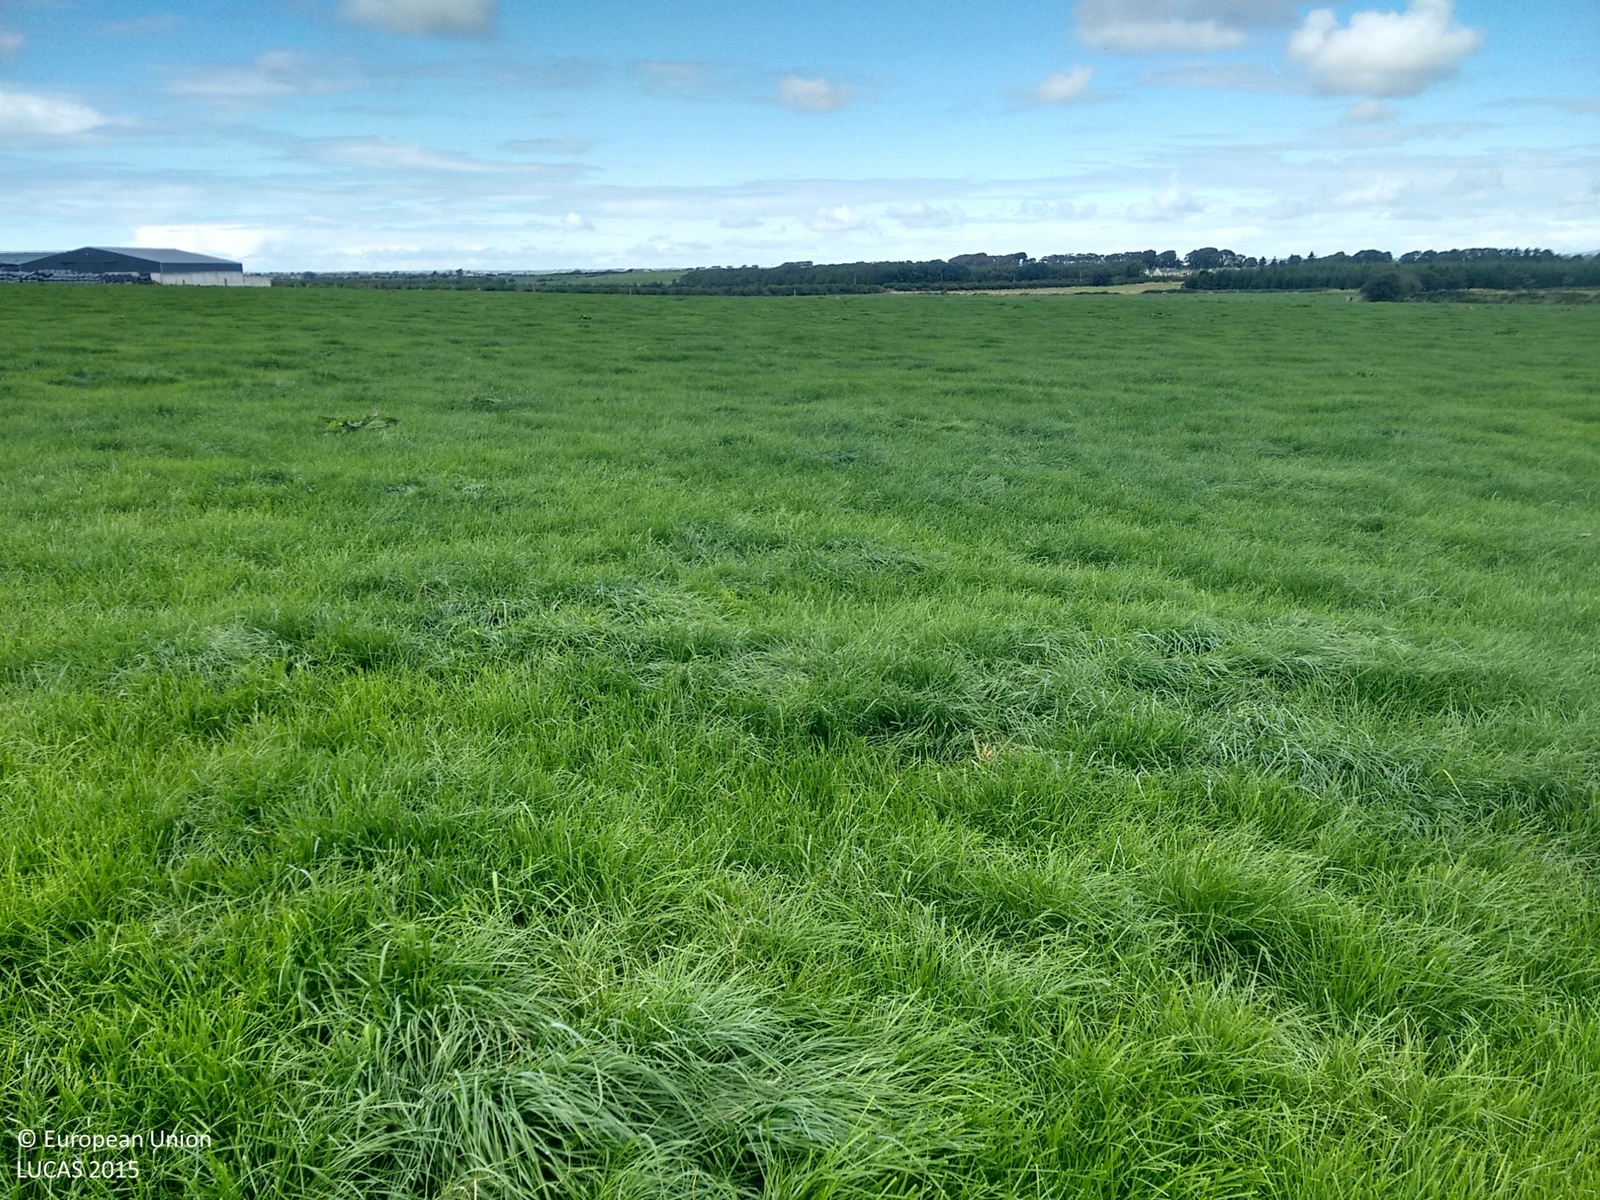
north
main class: Grassland
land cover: Grassland without tree/shrub cover
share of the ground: > 75 %
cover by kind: herbaceous plants 95 %, shrubs 5 %
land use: Agriculture (excluding fallow land and kitchen gardens)
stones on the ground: < 10 %
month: September
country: IE
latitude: 52.3482
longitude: -9.7230
